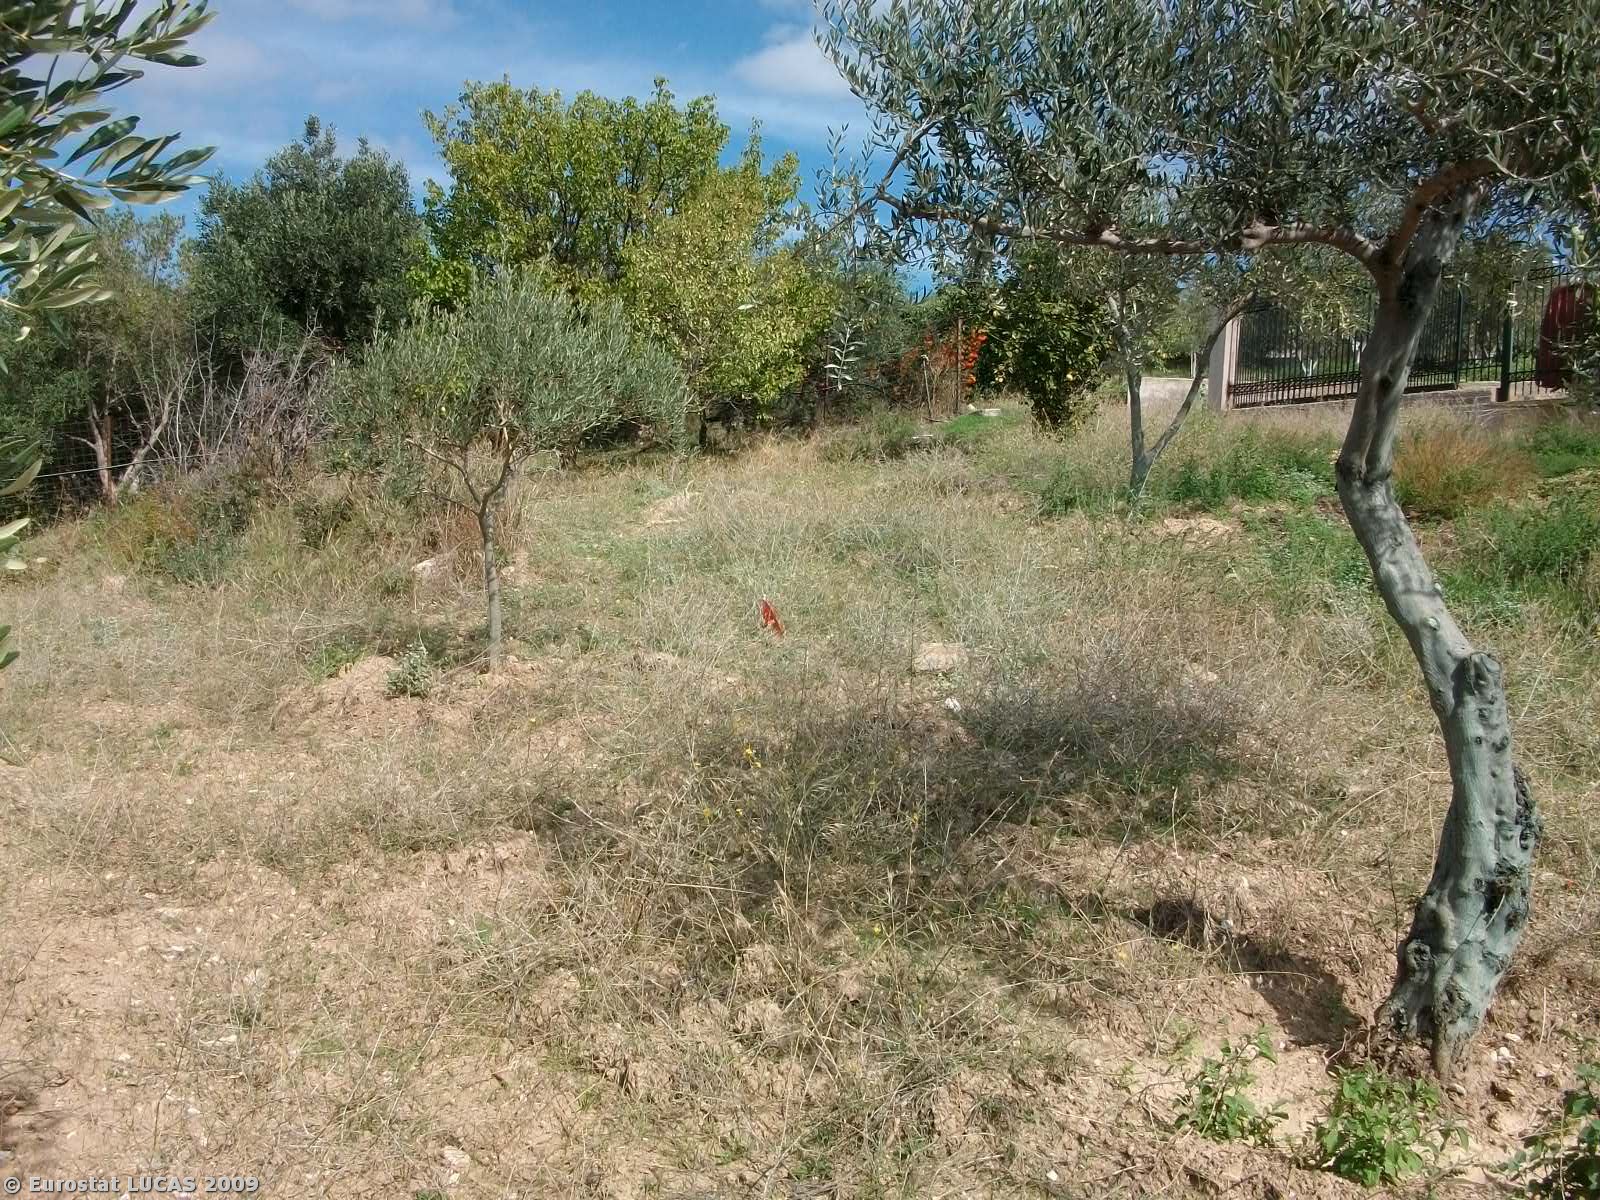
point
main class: Cropland
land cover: Olive groves
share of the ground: 25 - 50 %
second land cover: Grassland with sparse tree/shrub cover
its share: > 75 %
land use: Agriculture (excluding fallow land and kitchen gardens)
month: September
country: GR
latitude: 38.1364
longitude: 23.8924
